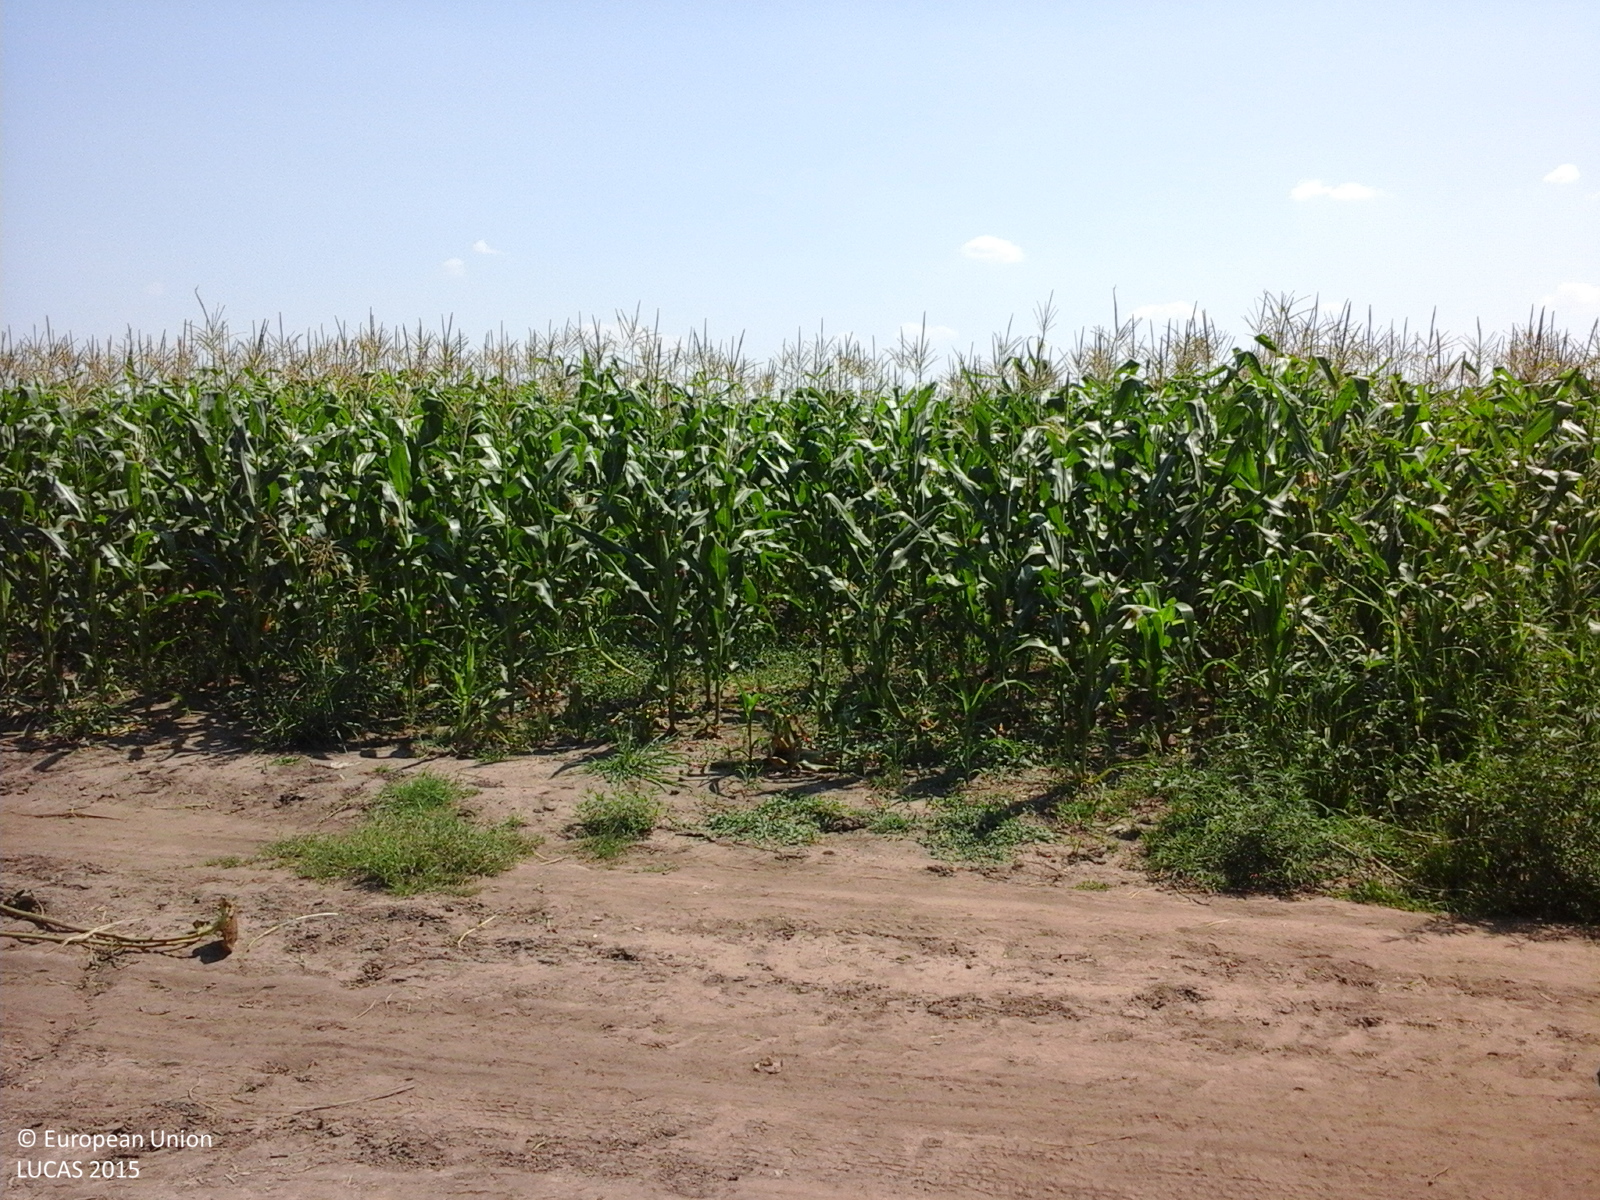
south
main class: Cropland
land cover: Sunflower
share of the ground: > 75 %
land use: Agriculture (excluding fallow land and kitchen gardens)
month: July
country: RO
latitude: 44.7843
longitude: 27.6029
